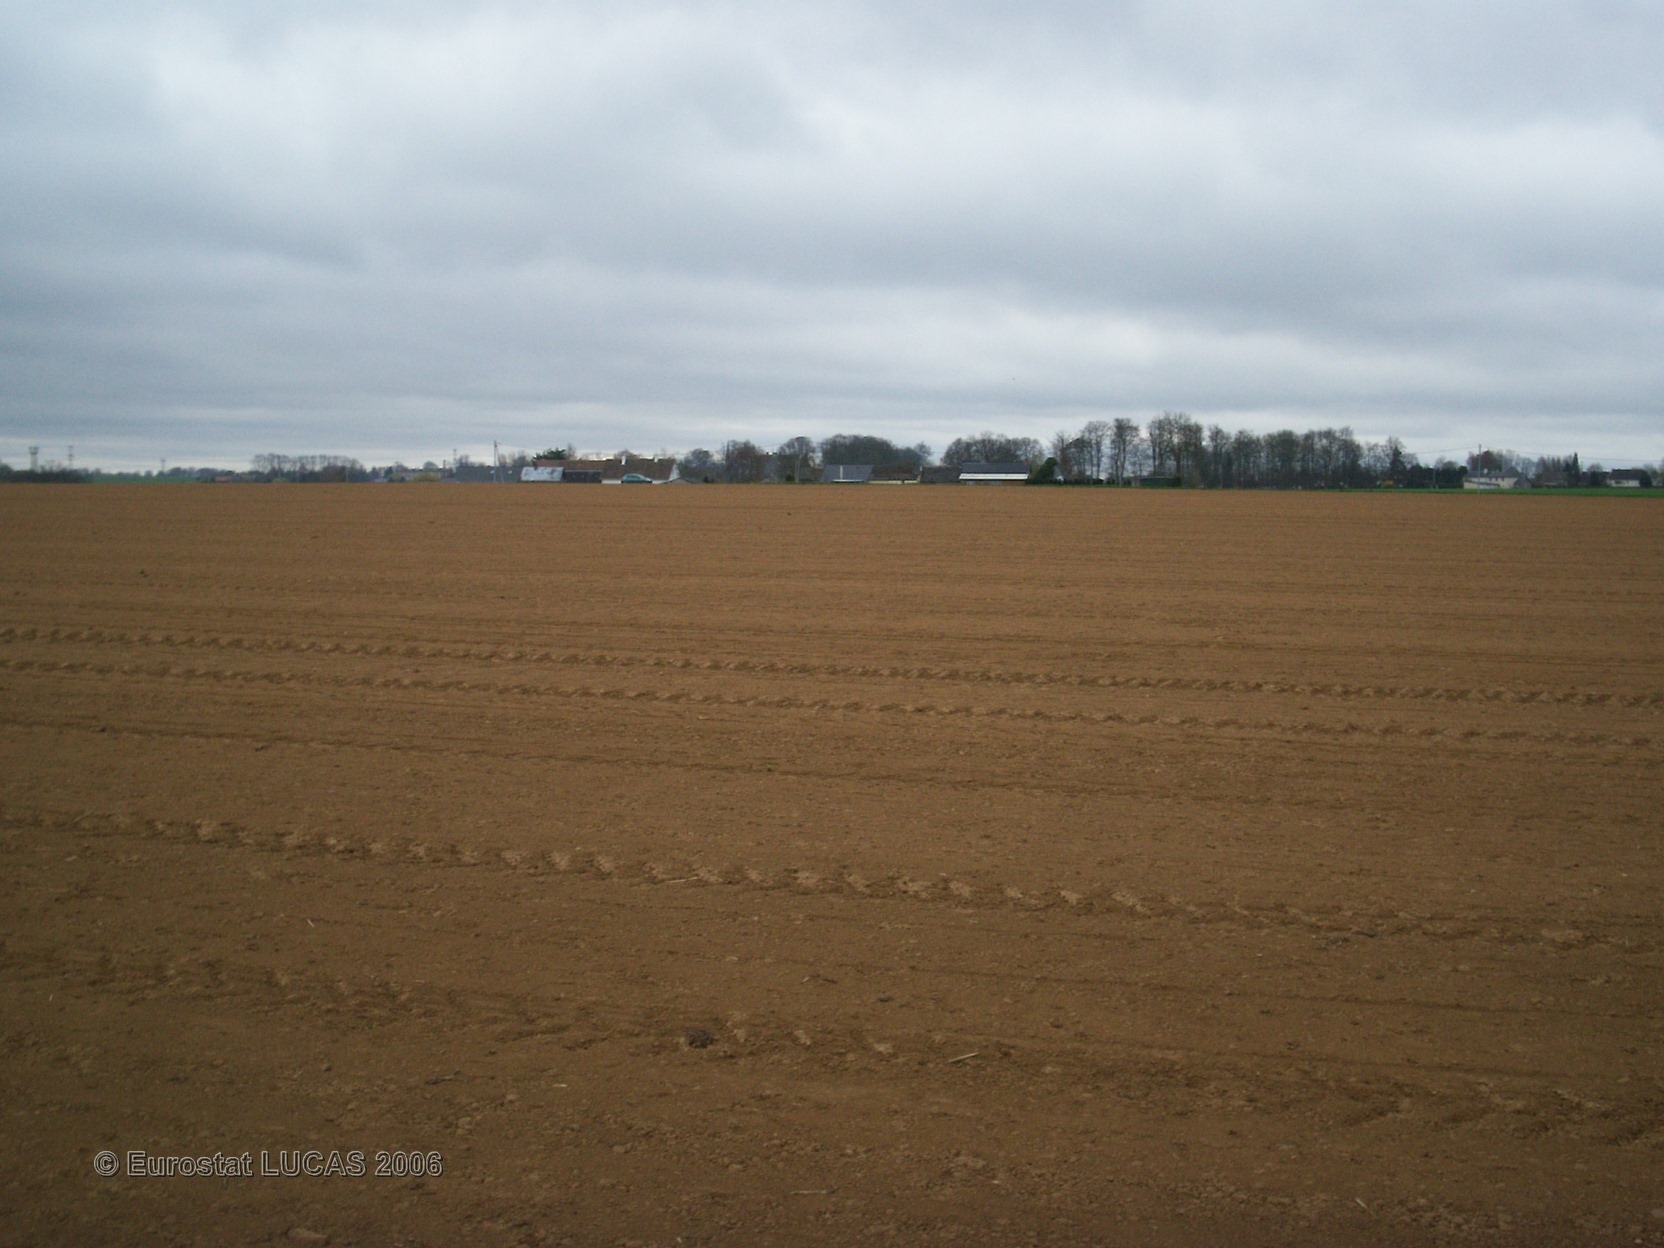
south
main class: Grassland
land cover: Grassland without tree/shrub cover
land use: Agriculture (excluding fallow land and kitchen gardens)
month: April
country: FR
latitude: 49.5145
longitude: 0.9302
